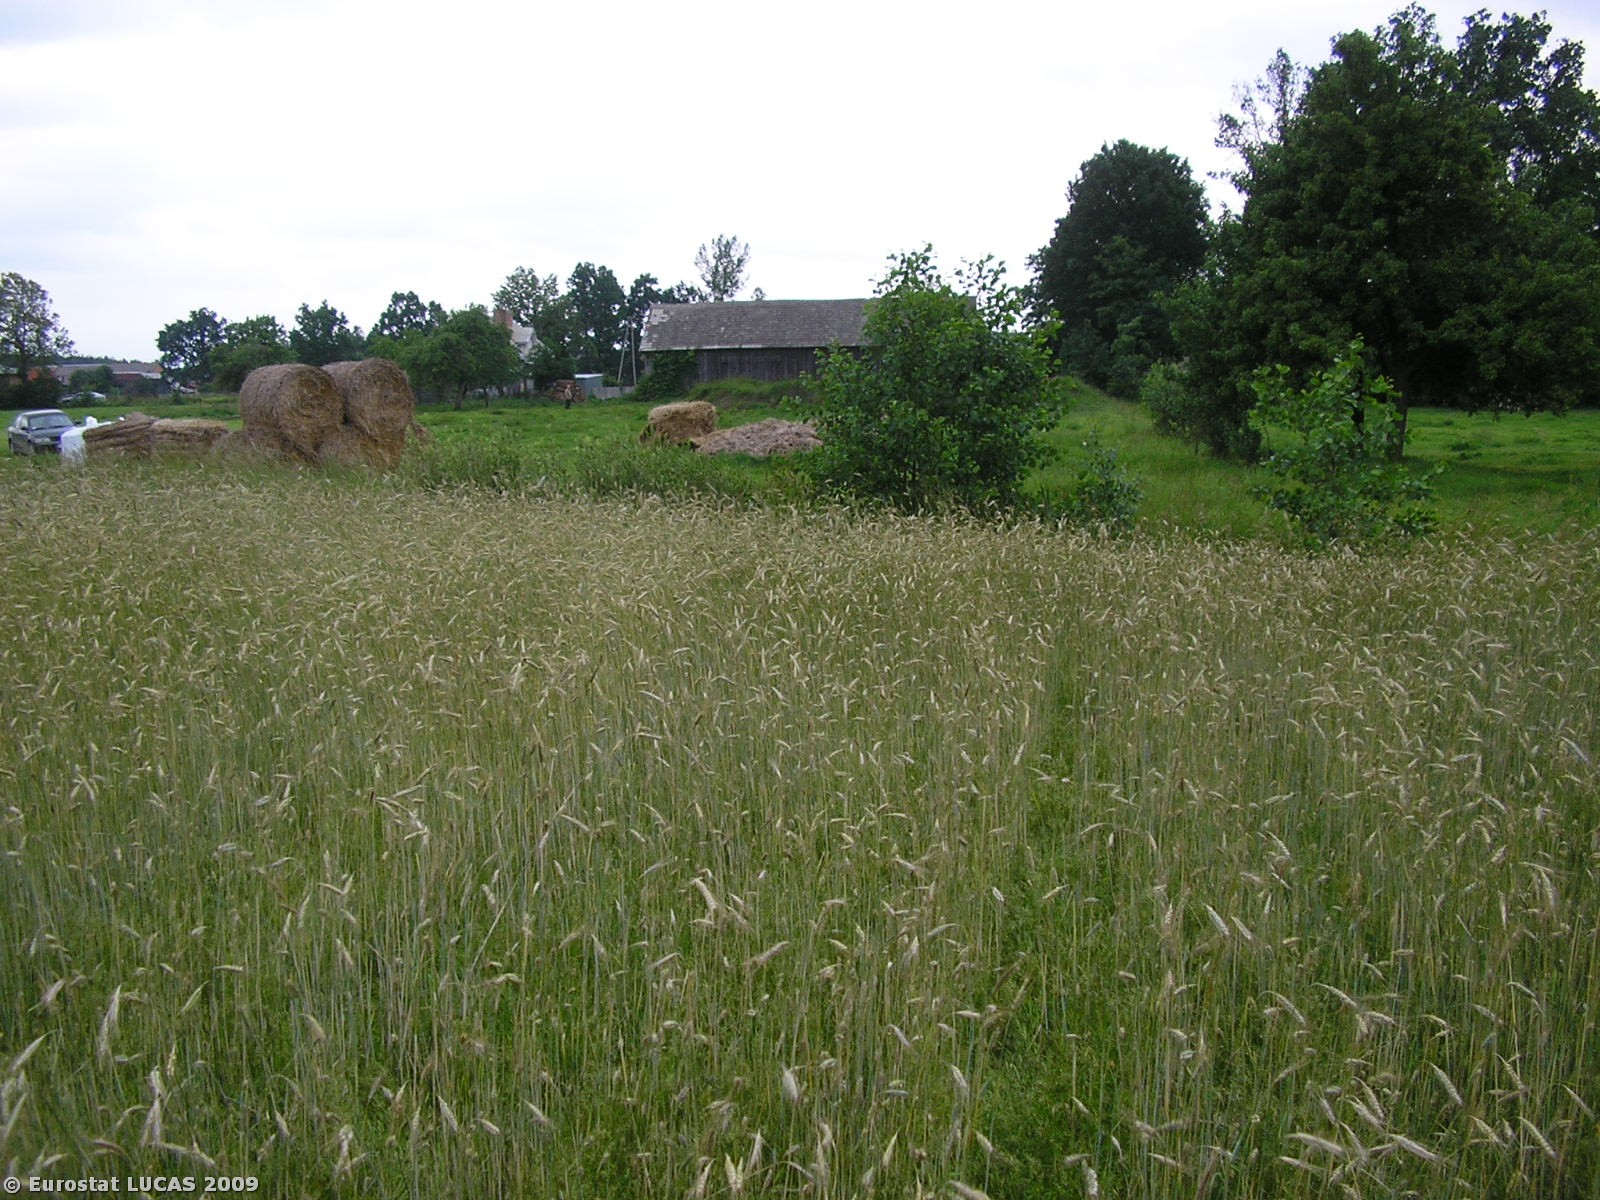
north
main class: Cropland
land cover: Rye
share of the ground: > 75 %
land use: Agriculture (excluding fallow land and kitchen gardens)
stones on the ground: < 10 %
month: June
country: PL
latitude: 51.4661
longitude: 18.3819
